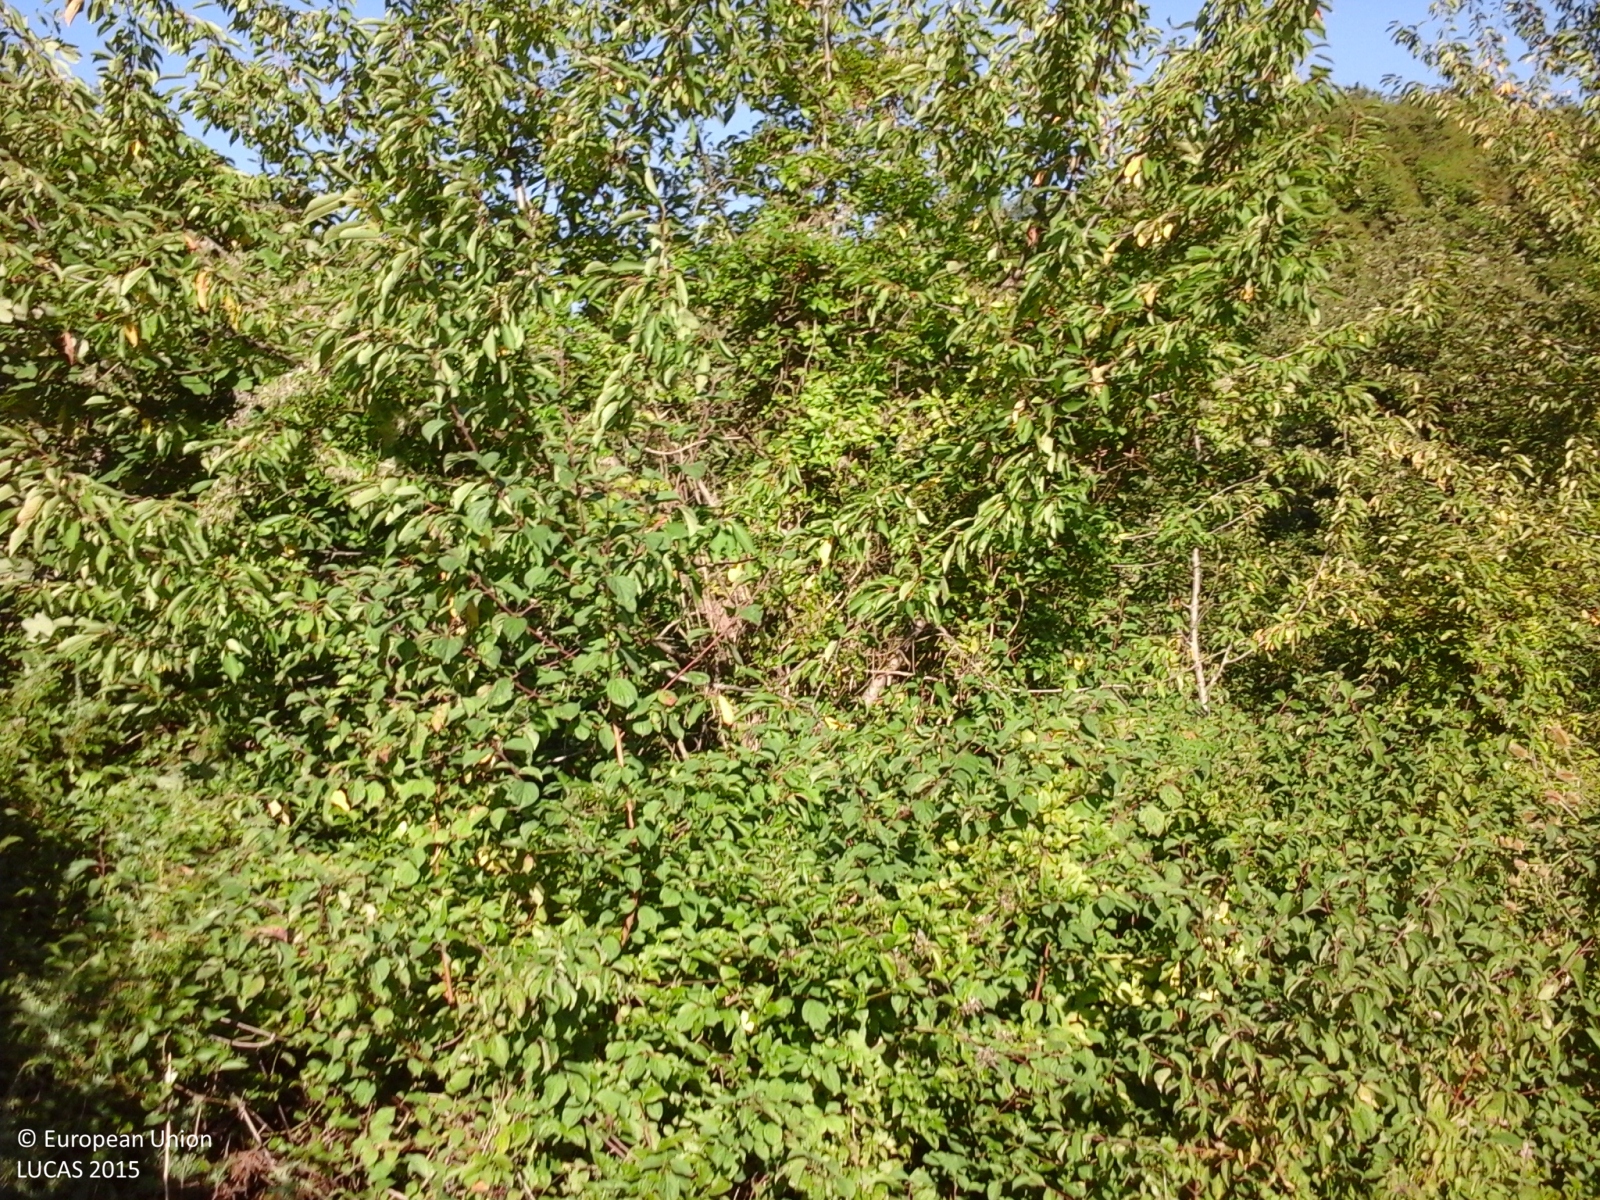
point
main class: Woodland
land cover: Broadleaved woodland
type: thermophilous deciduous forest
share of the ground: > 75 %
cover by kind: broadleaved forest trees 100 %
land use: Semi-natural and natural areas not in use
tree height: > 5 m
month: August
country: IT
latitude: 43.4924
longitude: 12.4050
